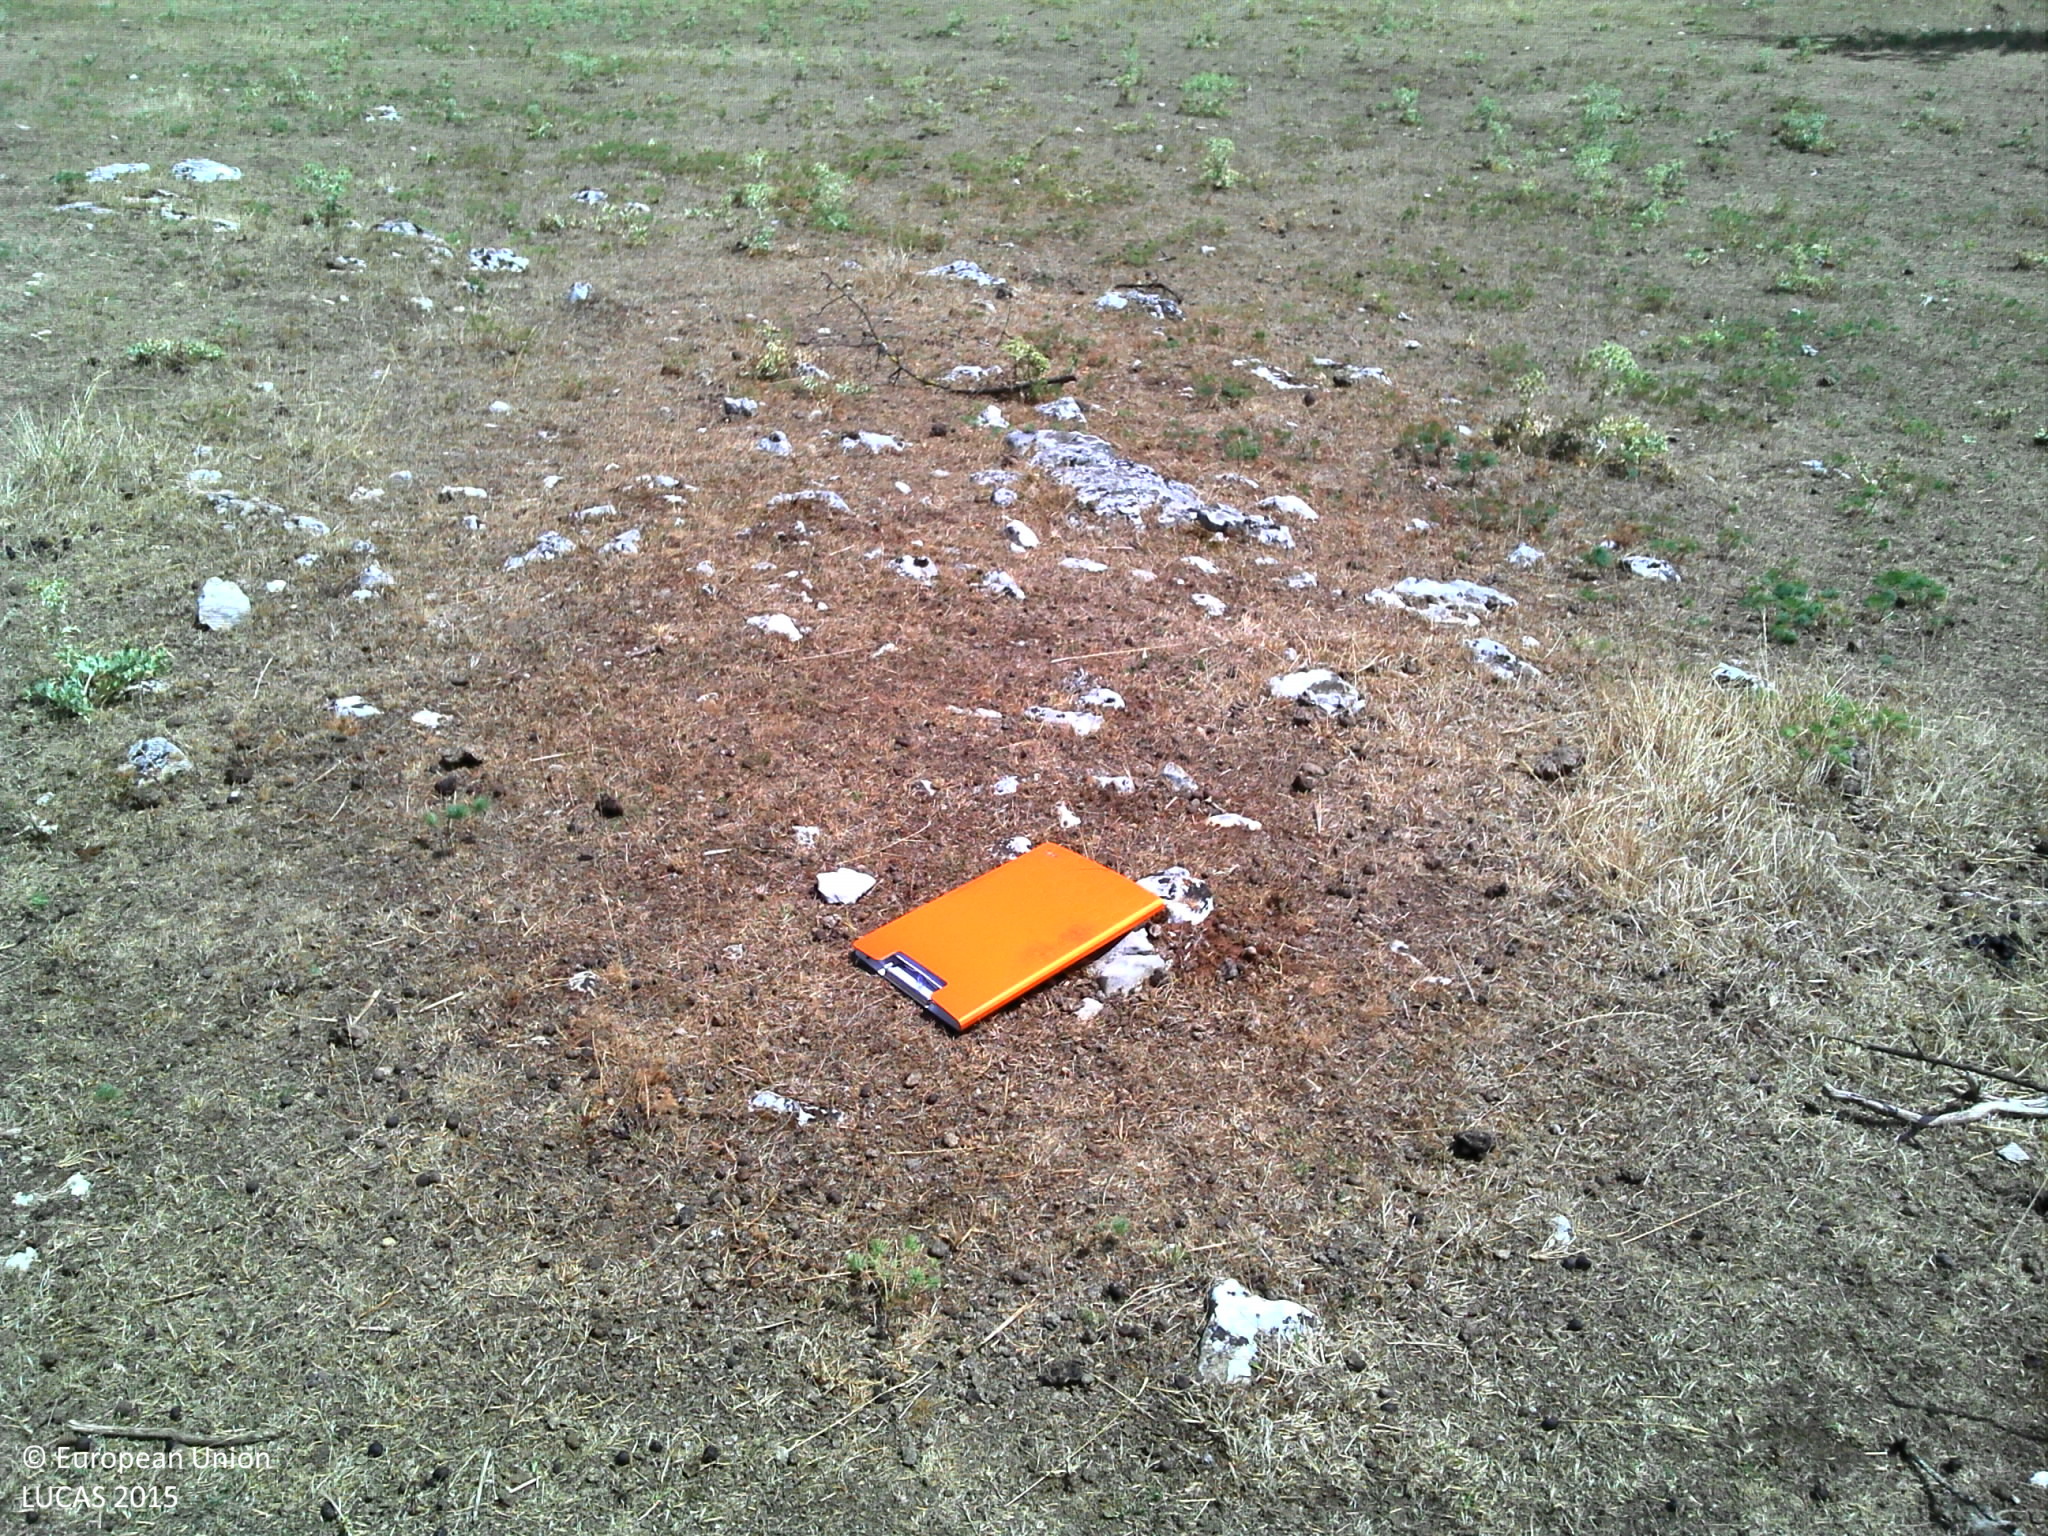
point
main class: Grassland
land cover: Grassland with sparse tree/shrub cover
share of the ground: > 75 %
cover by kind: herbaceous plants 85 %, shrubs 10 %, broadleaved forest trees 5 %
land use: Agriculture (excluding fallow land and kitchen gardens)
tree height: > 5 m
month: July
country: FR
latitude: 47.7131
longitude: 5.4018
